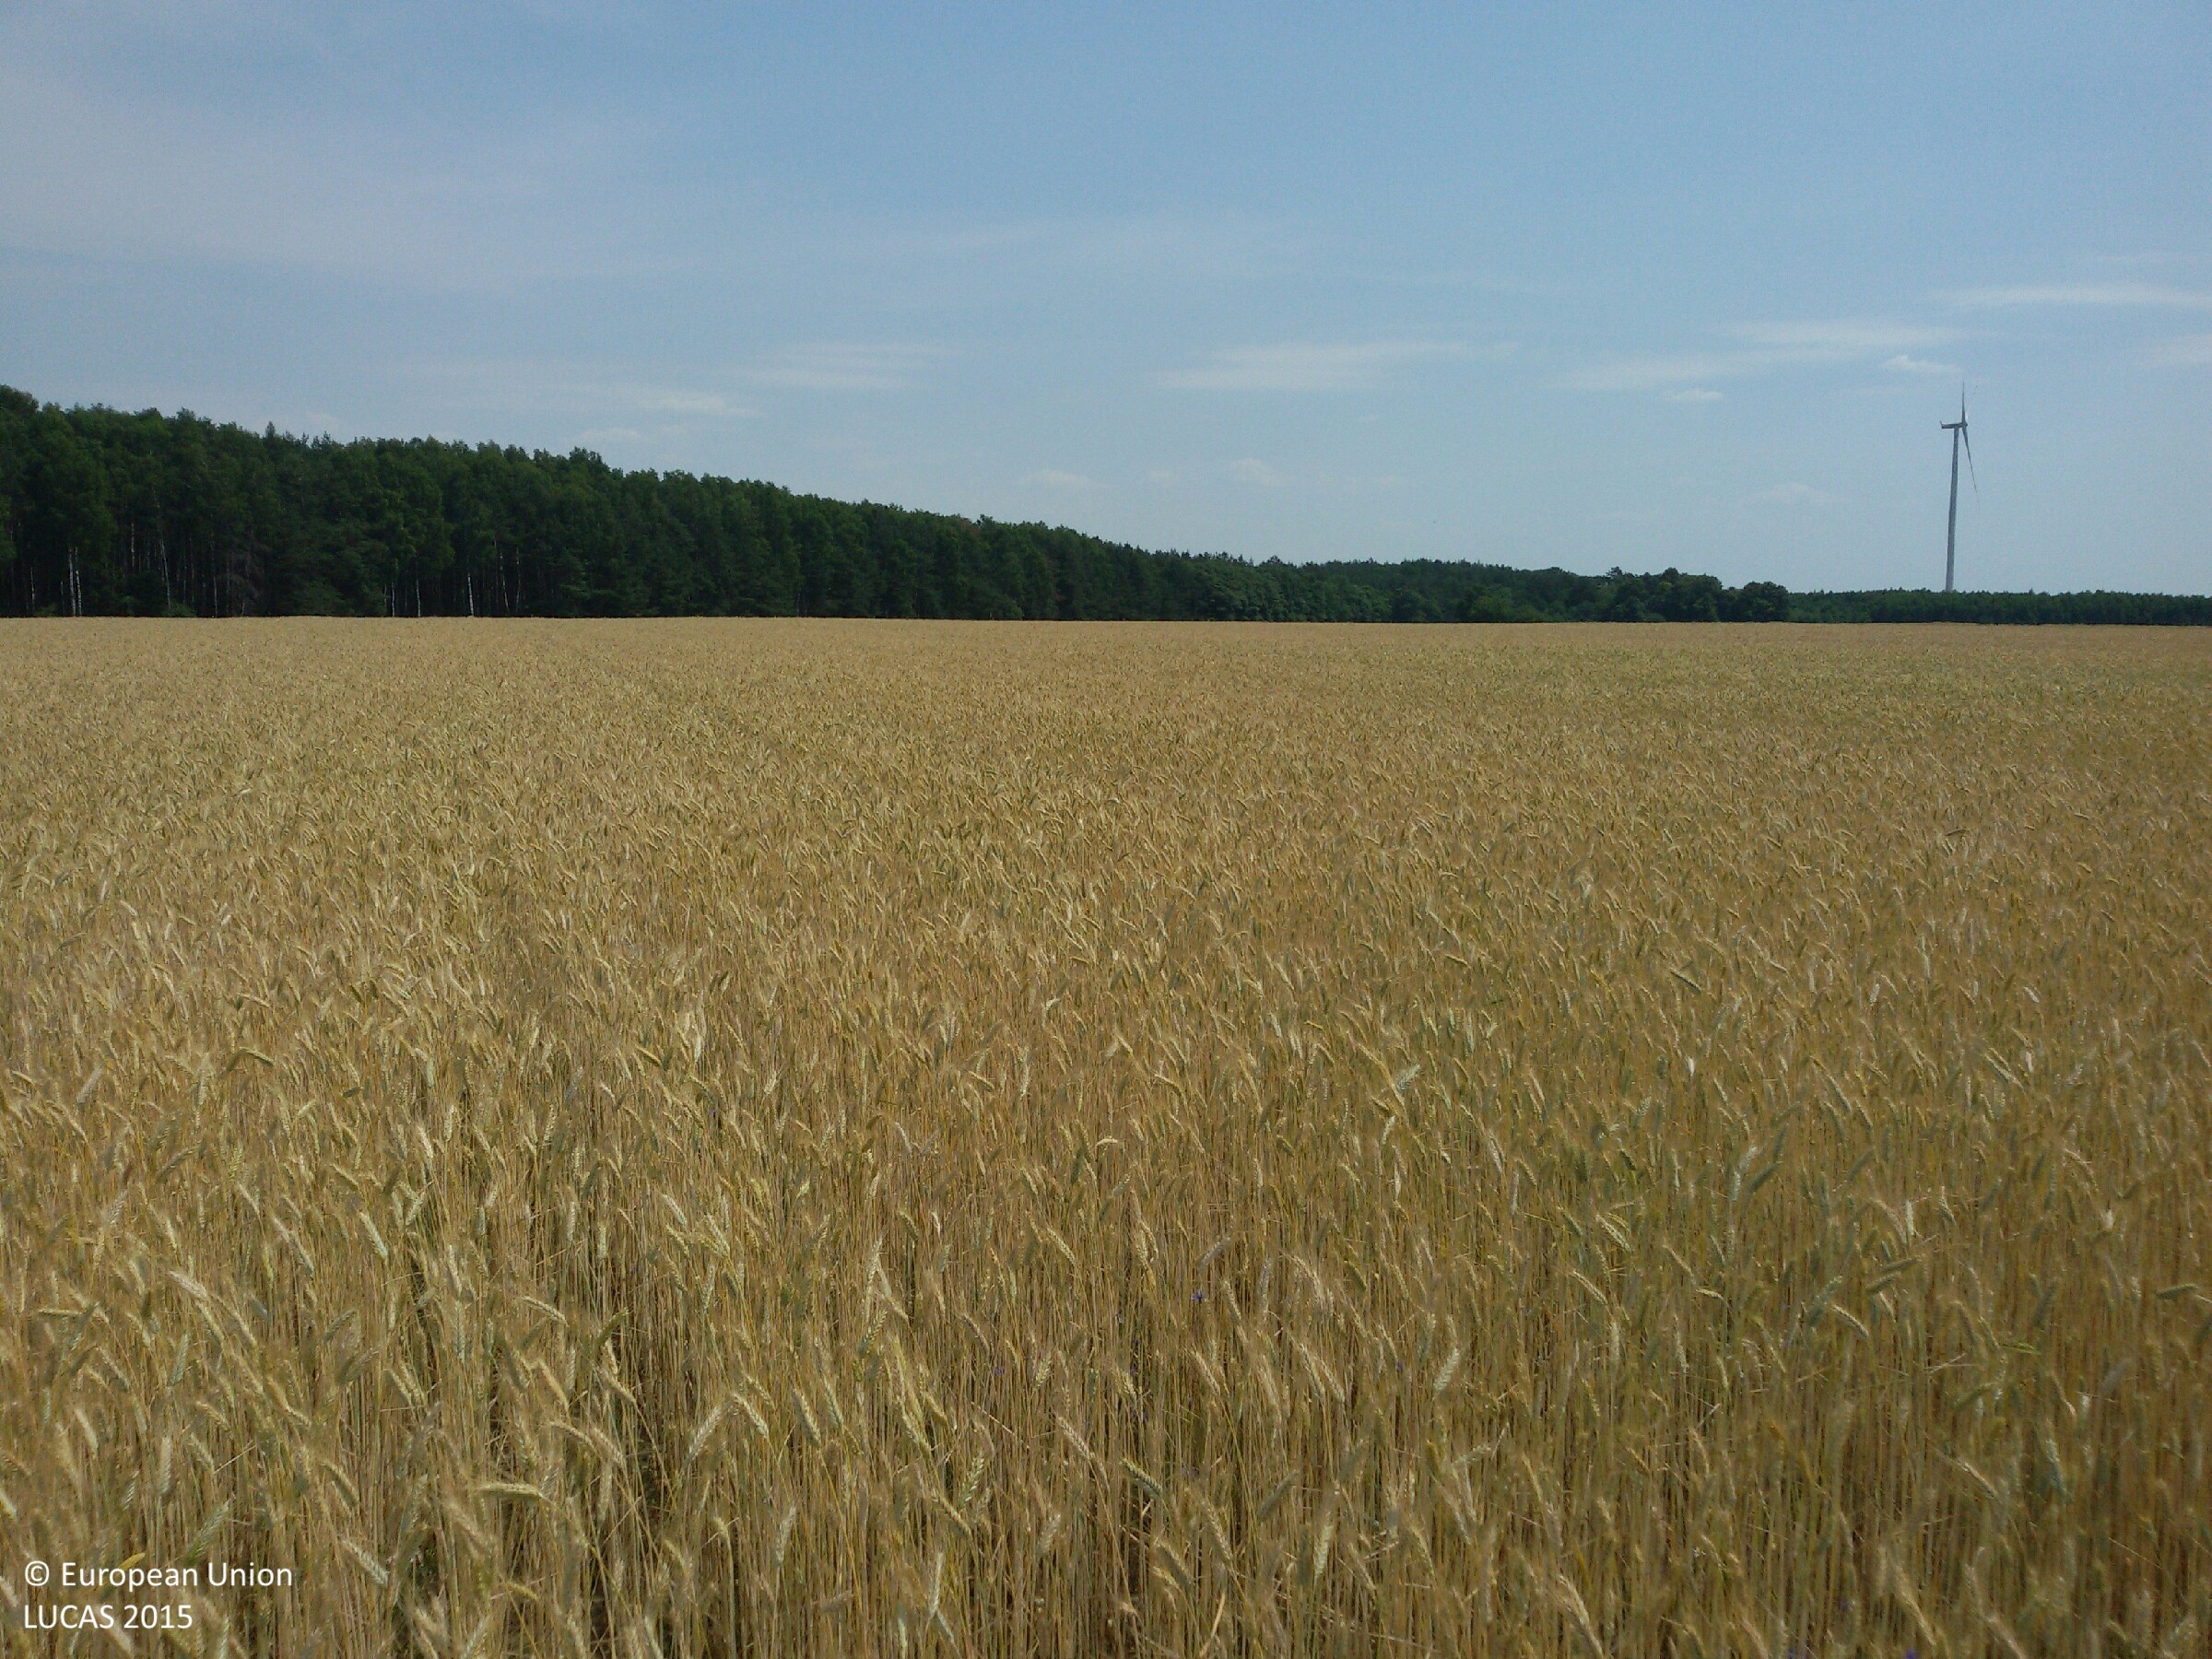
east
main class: Cropland
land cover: Common wheat
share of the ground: > 75 %
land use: Agriculture (excluding fallow land and kitchen gardens)
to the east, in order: Common wheat
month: July
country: PL
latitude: 53.2869
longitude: 20.0982
